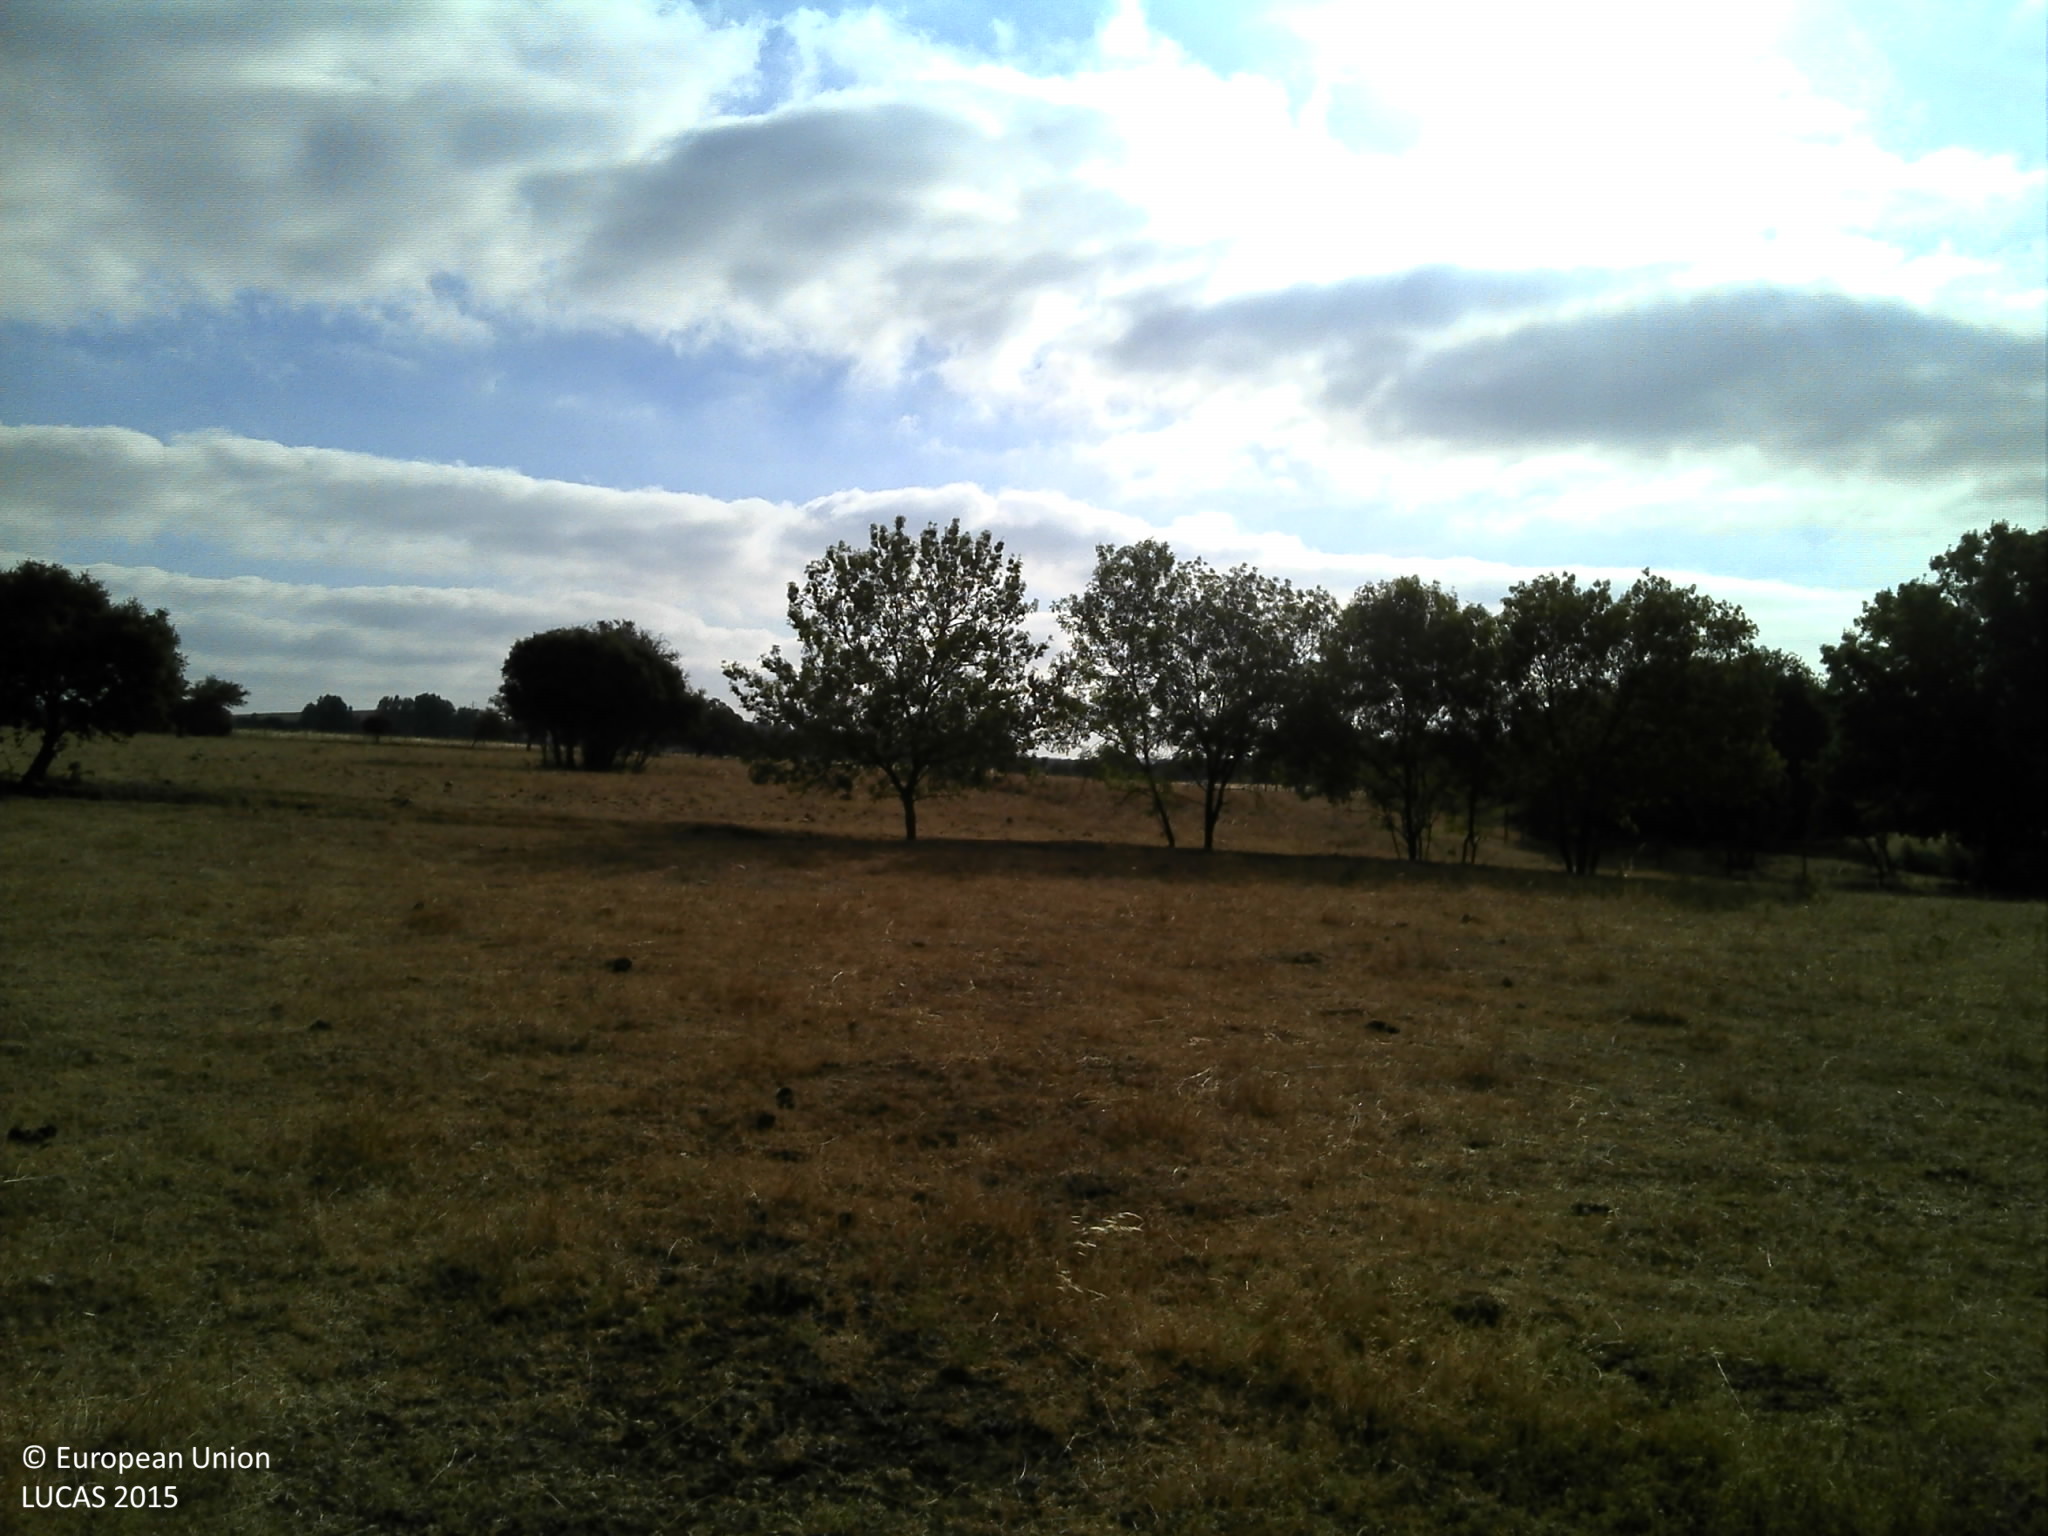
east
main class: Grassland
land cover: Grassland without tree/shrub cover
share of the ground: 10 - 25 %
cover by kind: unconsolidated bare surface 90 %, herbaceous plants 10 %
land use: Agriculture (excluding fallow land and kitchen gardens)
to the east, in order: Grassland without tree/shrub cover; Fences; Broadleaved woodland; Inland fresh running water; Broadleaved woodland; Grassland without tree/shrub cover; Broadleaved woodland; Inland fresh running water; Broadleaved woodland; Inland fresh running water; Broadleaved woodland
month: June
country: PT
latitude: 38.2120
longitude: -7.9298
